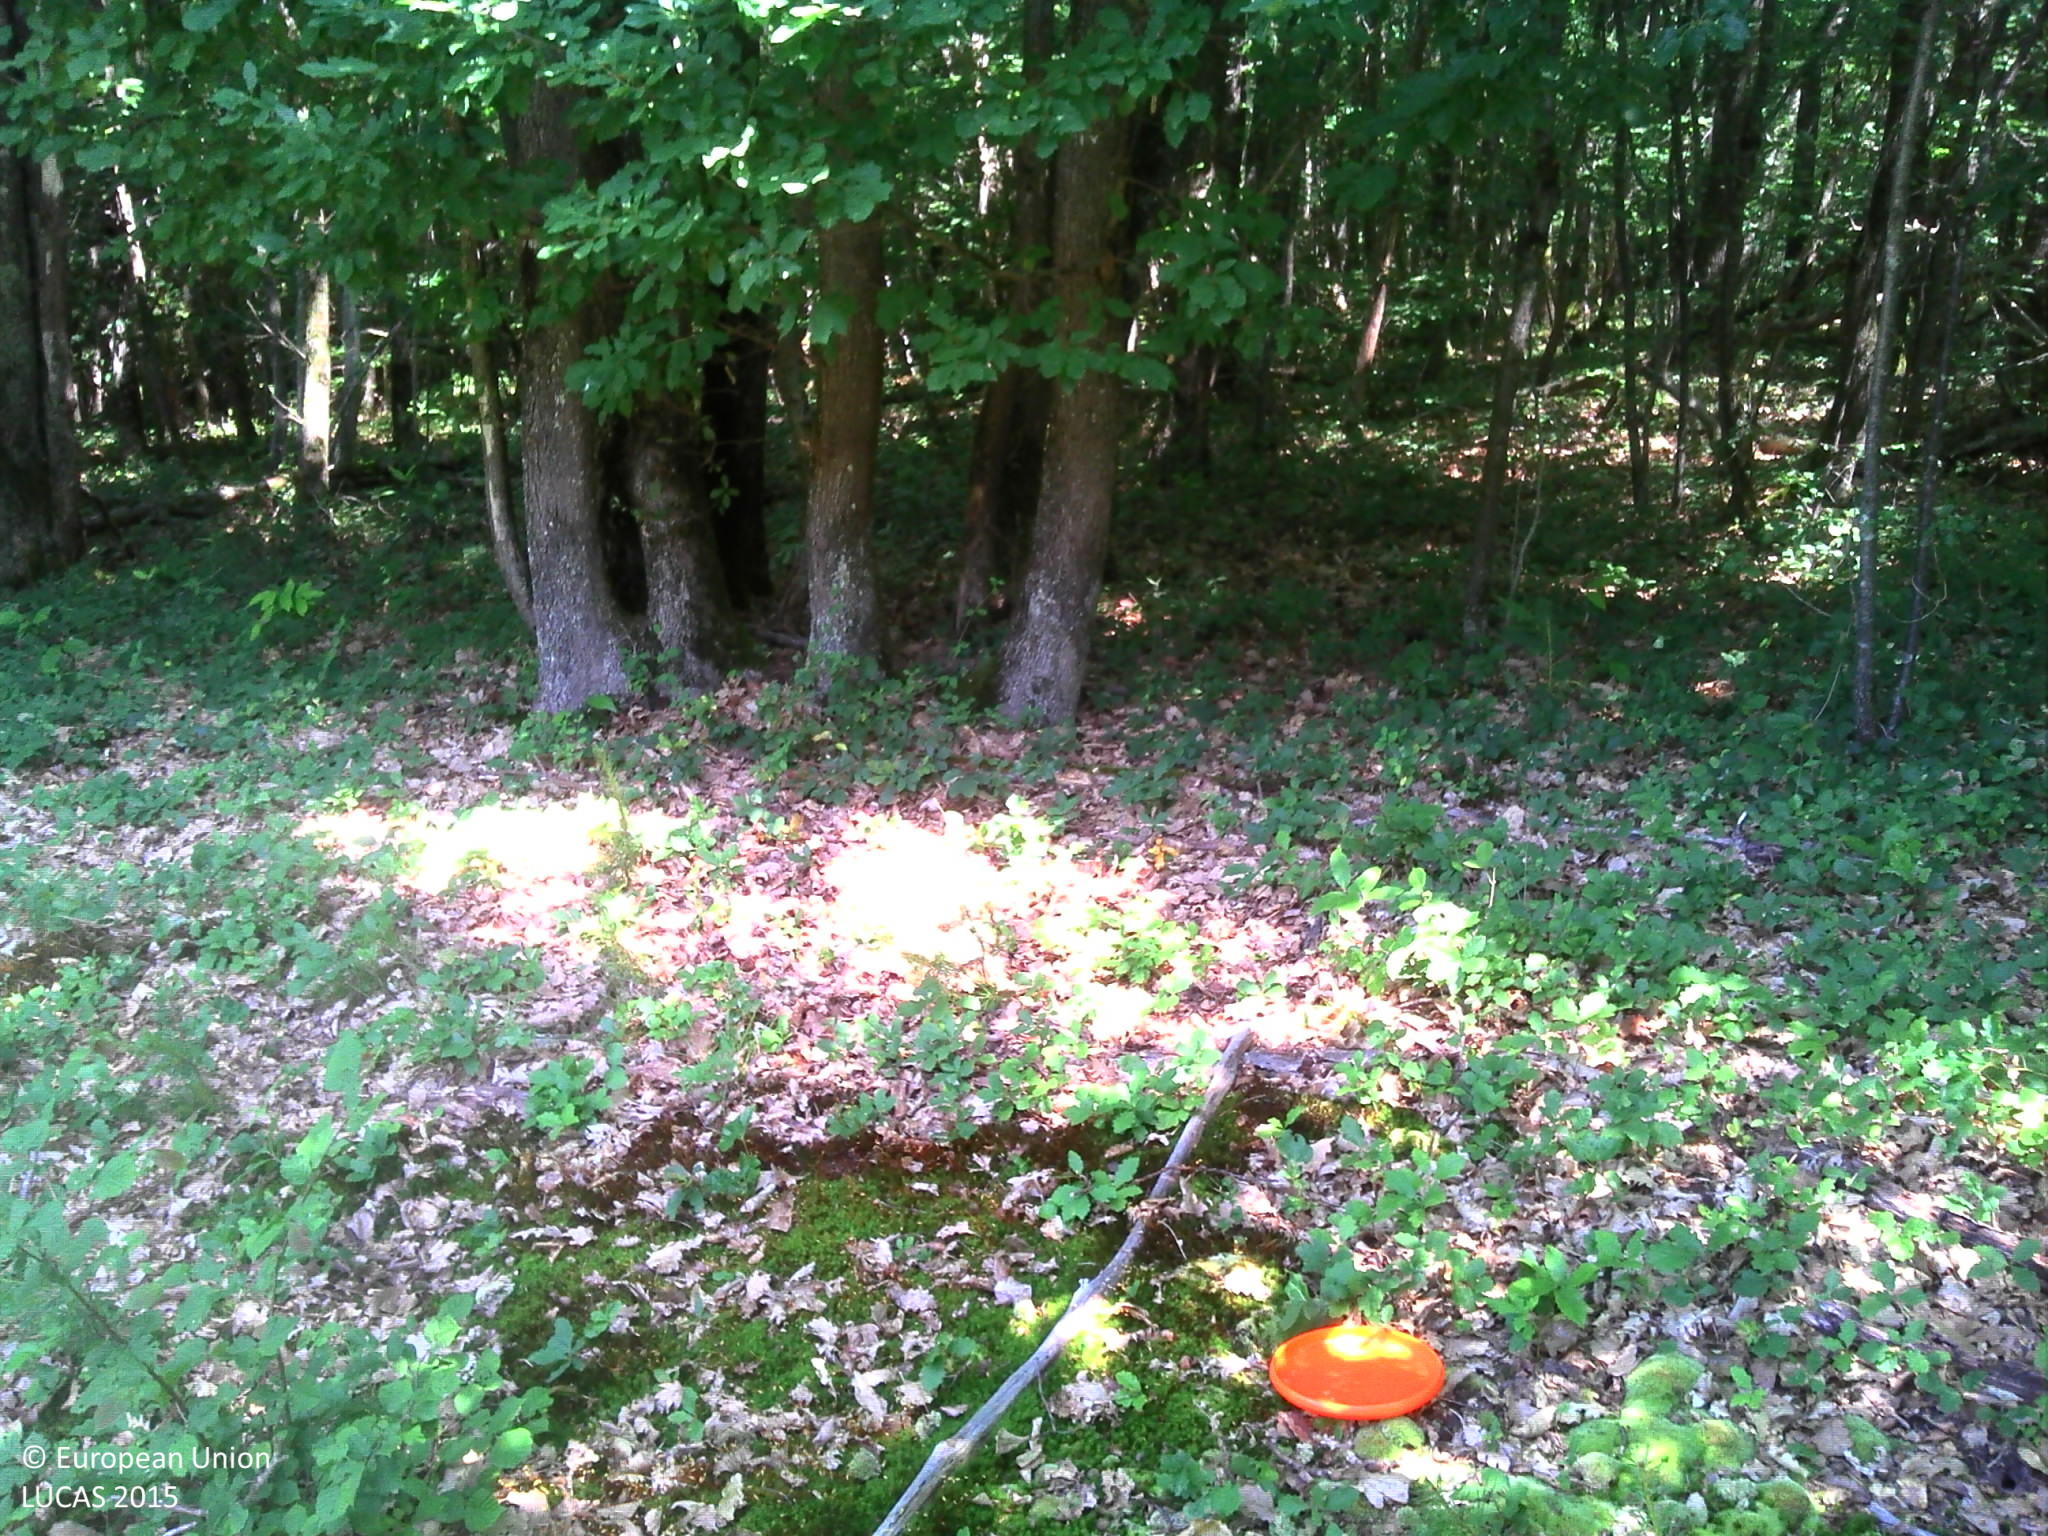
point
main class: Woodland
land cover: Broadleaved woodland
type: mesophytic deciduous forest
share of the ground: > 75 %
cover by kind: broadleaved forest trees 80 %, herbaceous plants 10 %, coniferous forest trees 5 %, lichens and mosses 5 %
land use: Forestry
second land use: Amenities, museums, leisure
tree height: > 5 m
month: June
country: FR
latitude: 47.4368
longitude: 0.7657
